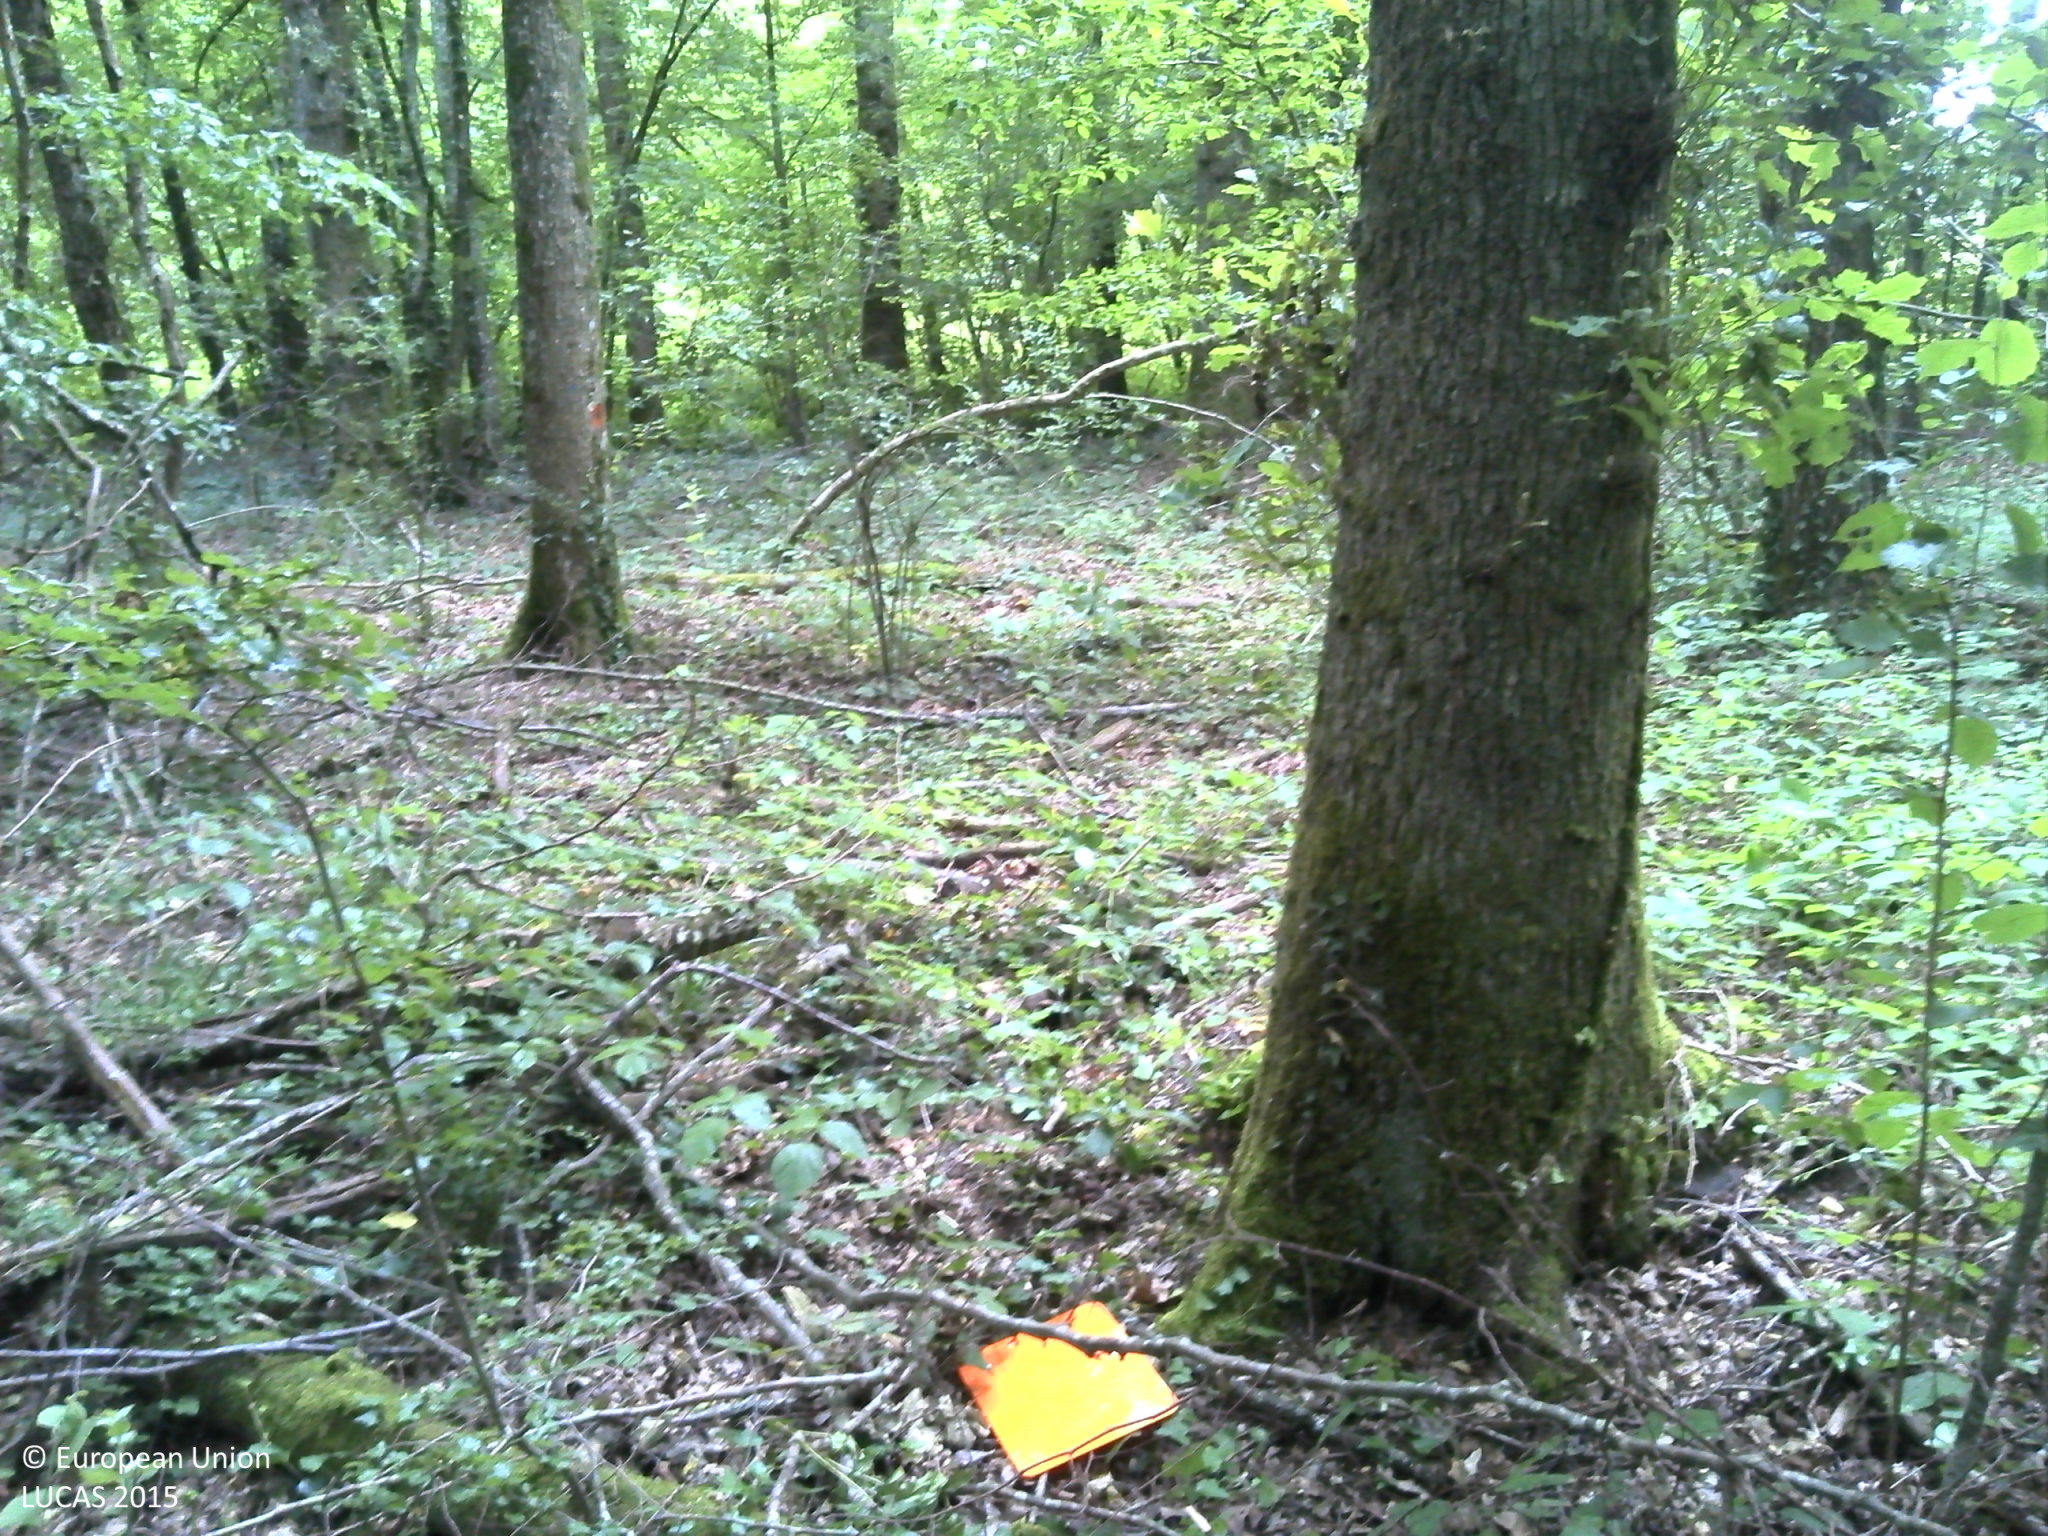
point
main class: Woodland
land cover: Broadleaved woodland
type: acidophilous oak and oak-birch forest
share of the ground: > 75 %
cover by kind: broadleaved forest trees 65 %, herbaceous plants 15 %, consolidated bare surface 15 %, lichens and mosses 5 %
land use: Forestry
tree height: > 5 m
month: July
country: FR
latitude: 49.7843
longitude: 4.5657
